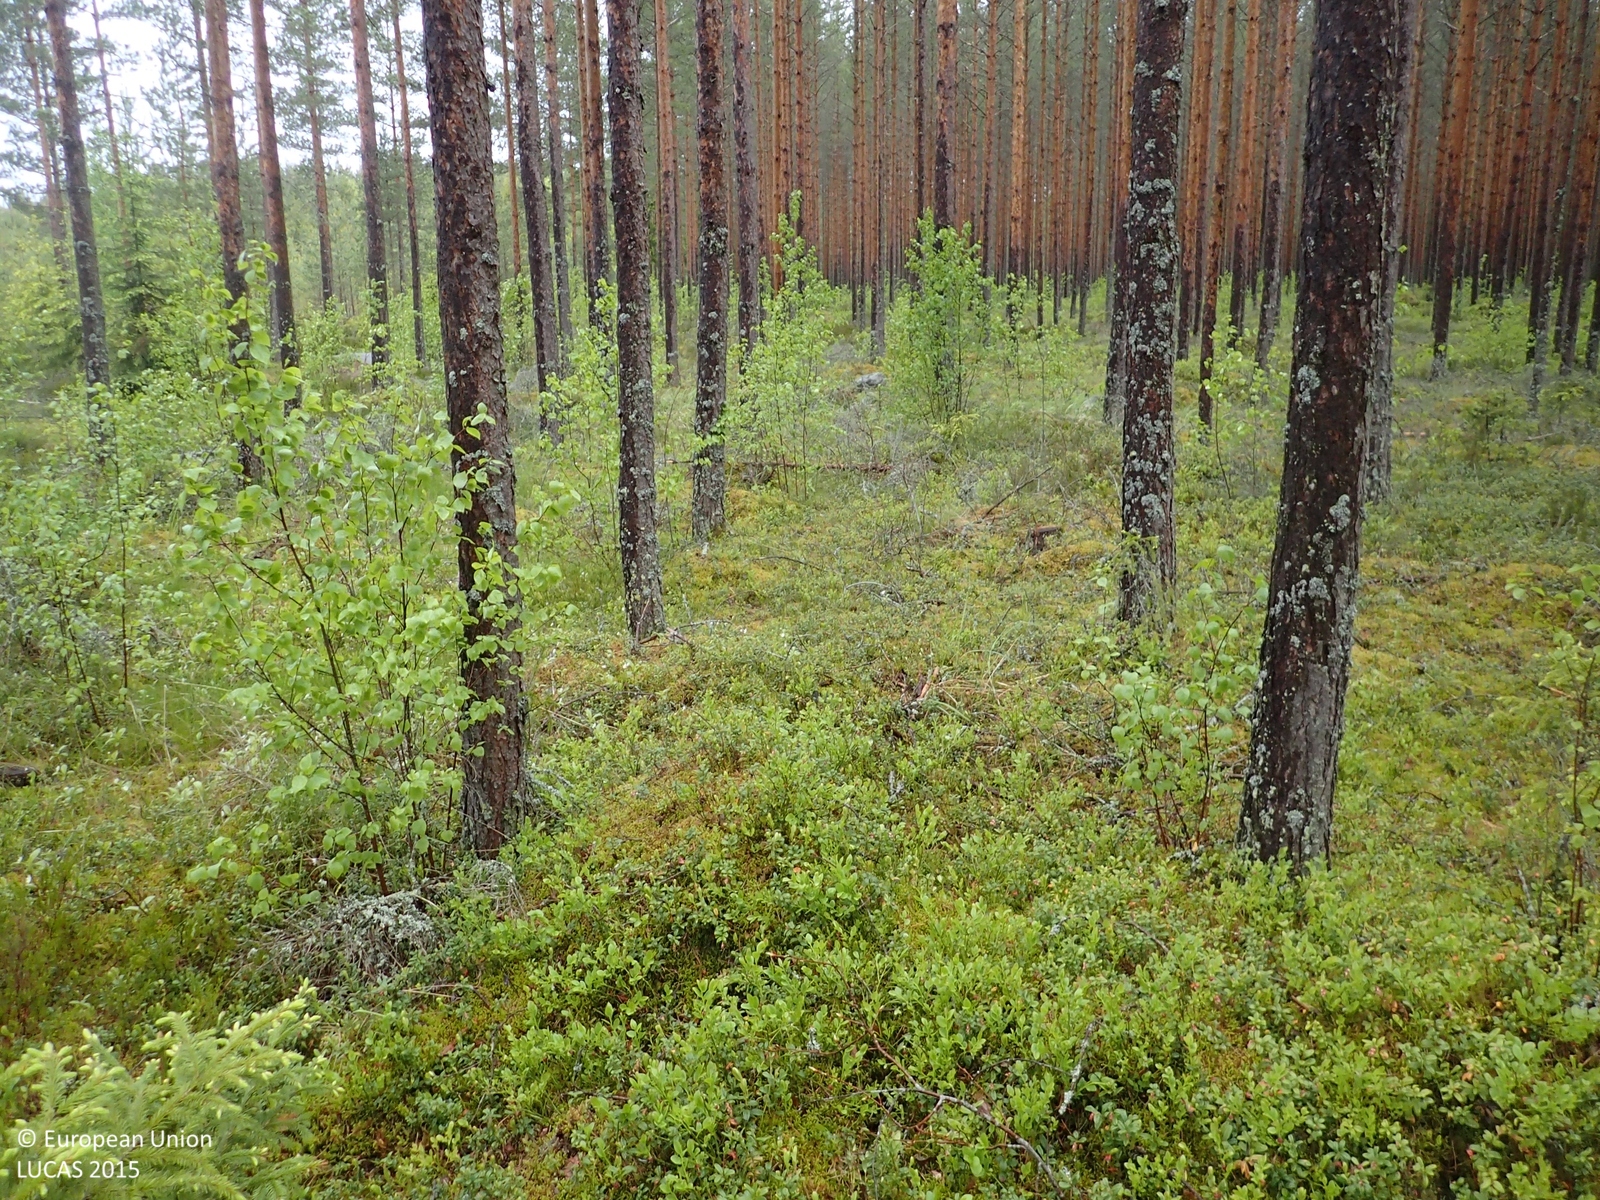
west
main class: Woodland
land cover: Pine dominated coniferous woodland
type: boreal forest
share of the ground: > 75 %
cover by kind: coniferous forest trees 65 %, shrubs 15 %, broadleaved forest trees 10 %, herbaceous plants 5 %, lichens and mosses 5 %
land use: Forestry
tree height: > 5 m
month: June
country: FI
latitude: 62.1785
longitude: 21.6285
